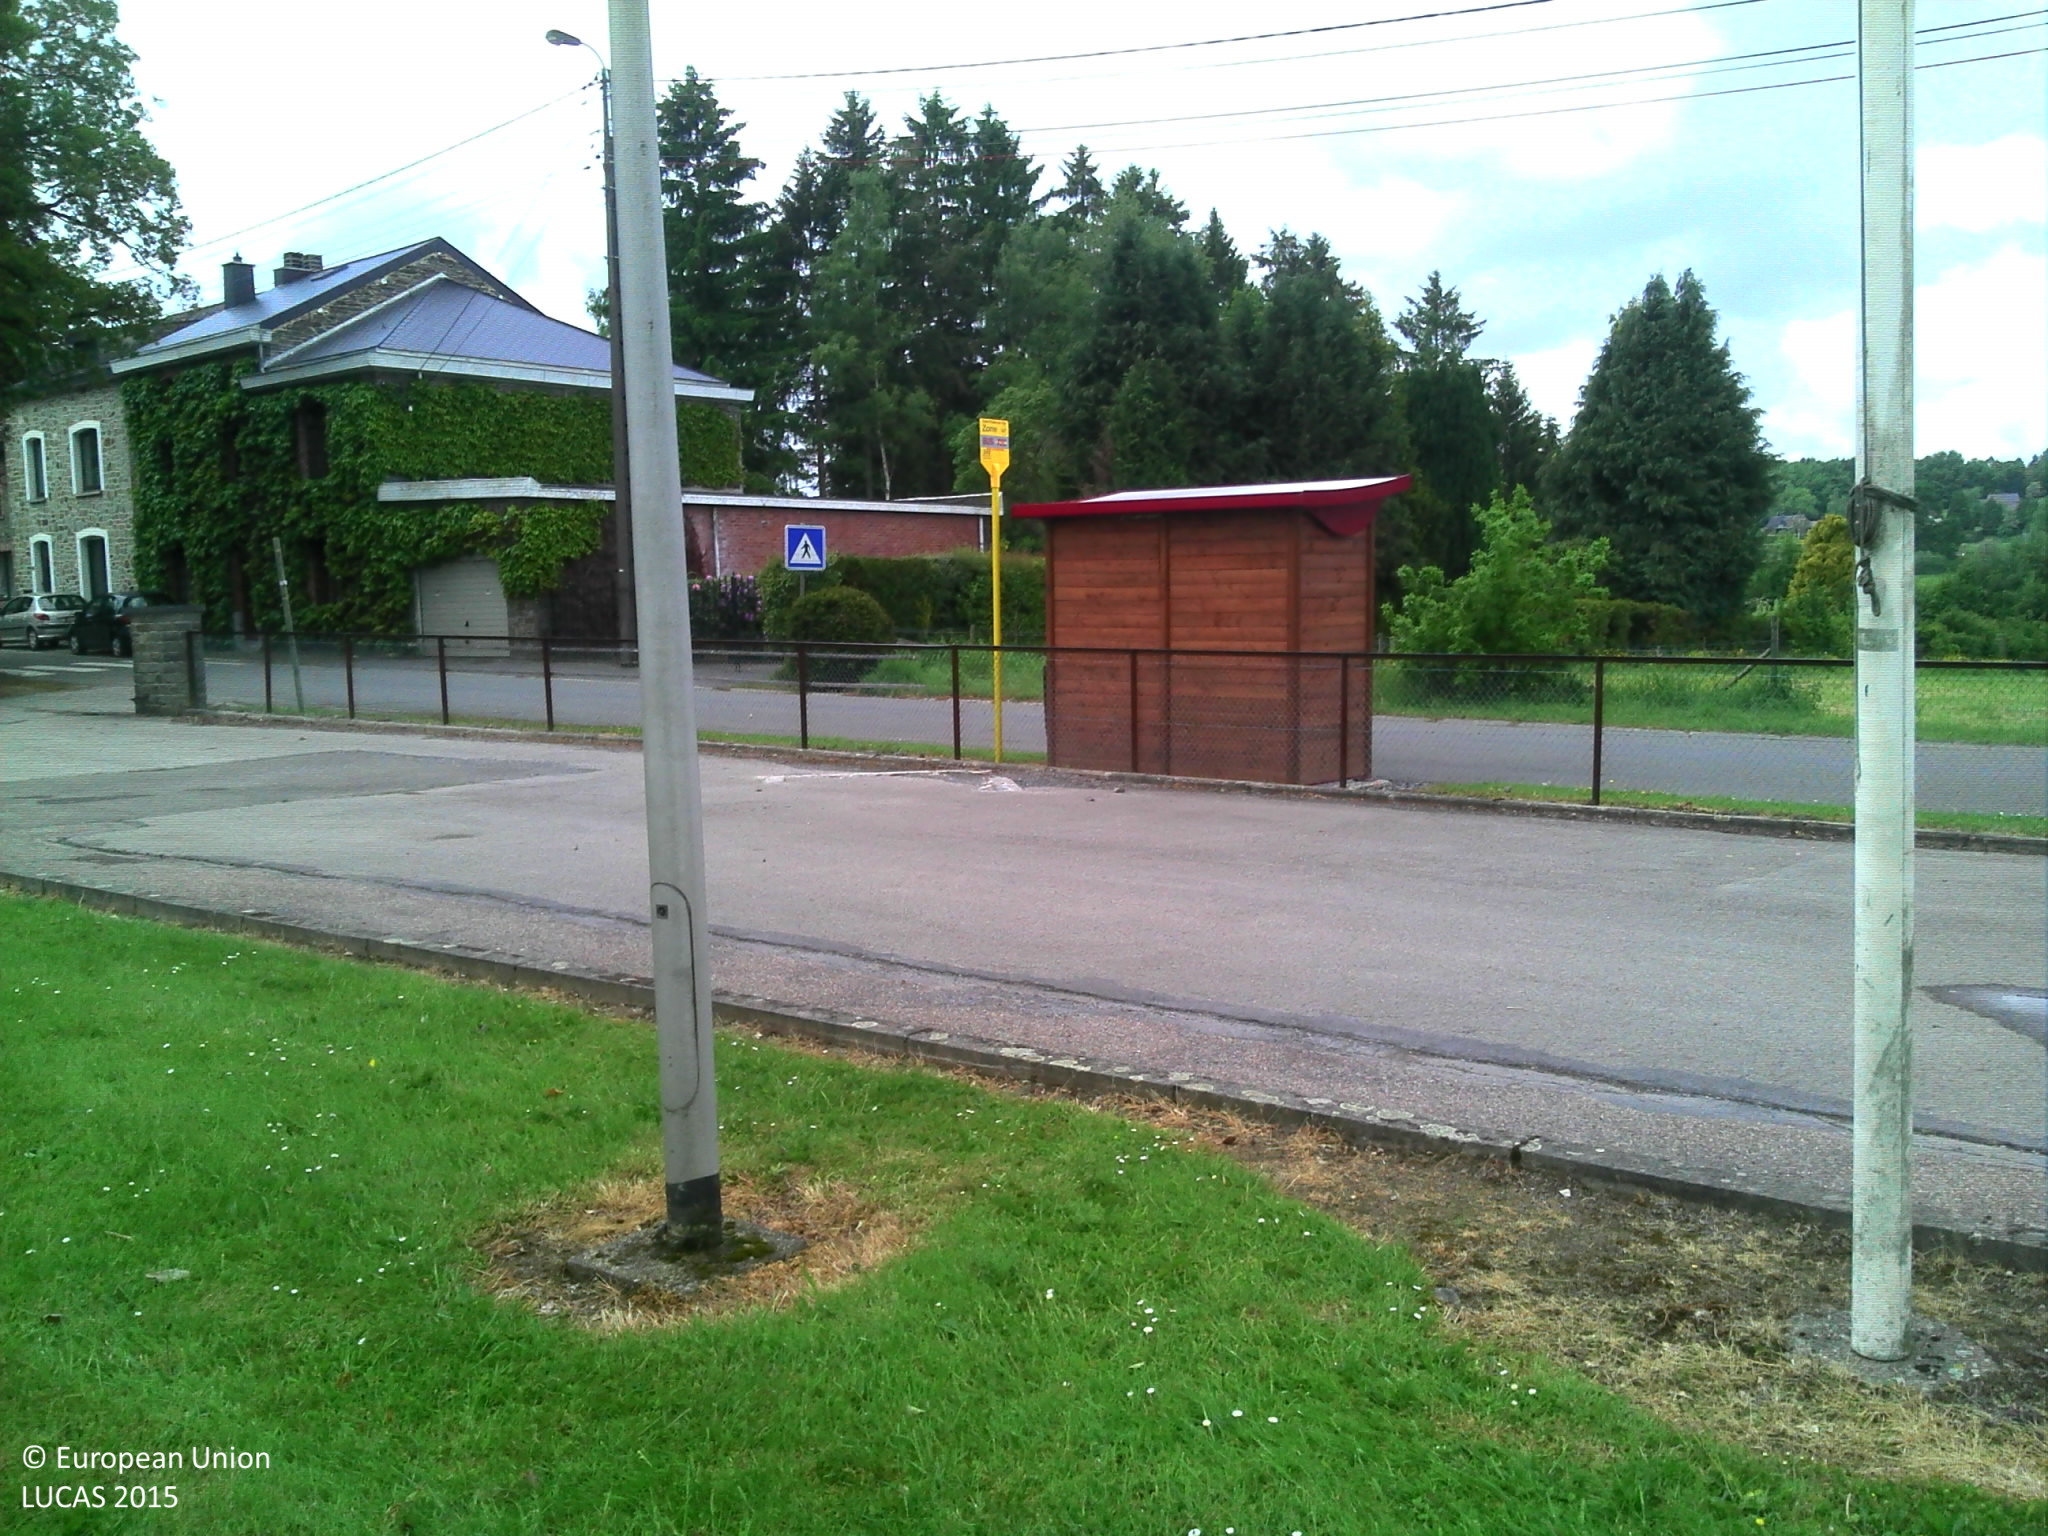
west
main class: Grassland
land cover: Grassland without tree/shrub cover
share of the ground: > 75 %
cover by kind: herbaceous plants 100 %
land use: Community services
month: June
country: BE
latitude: 50.2871
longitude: 5.8023
